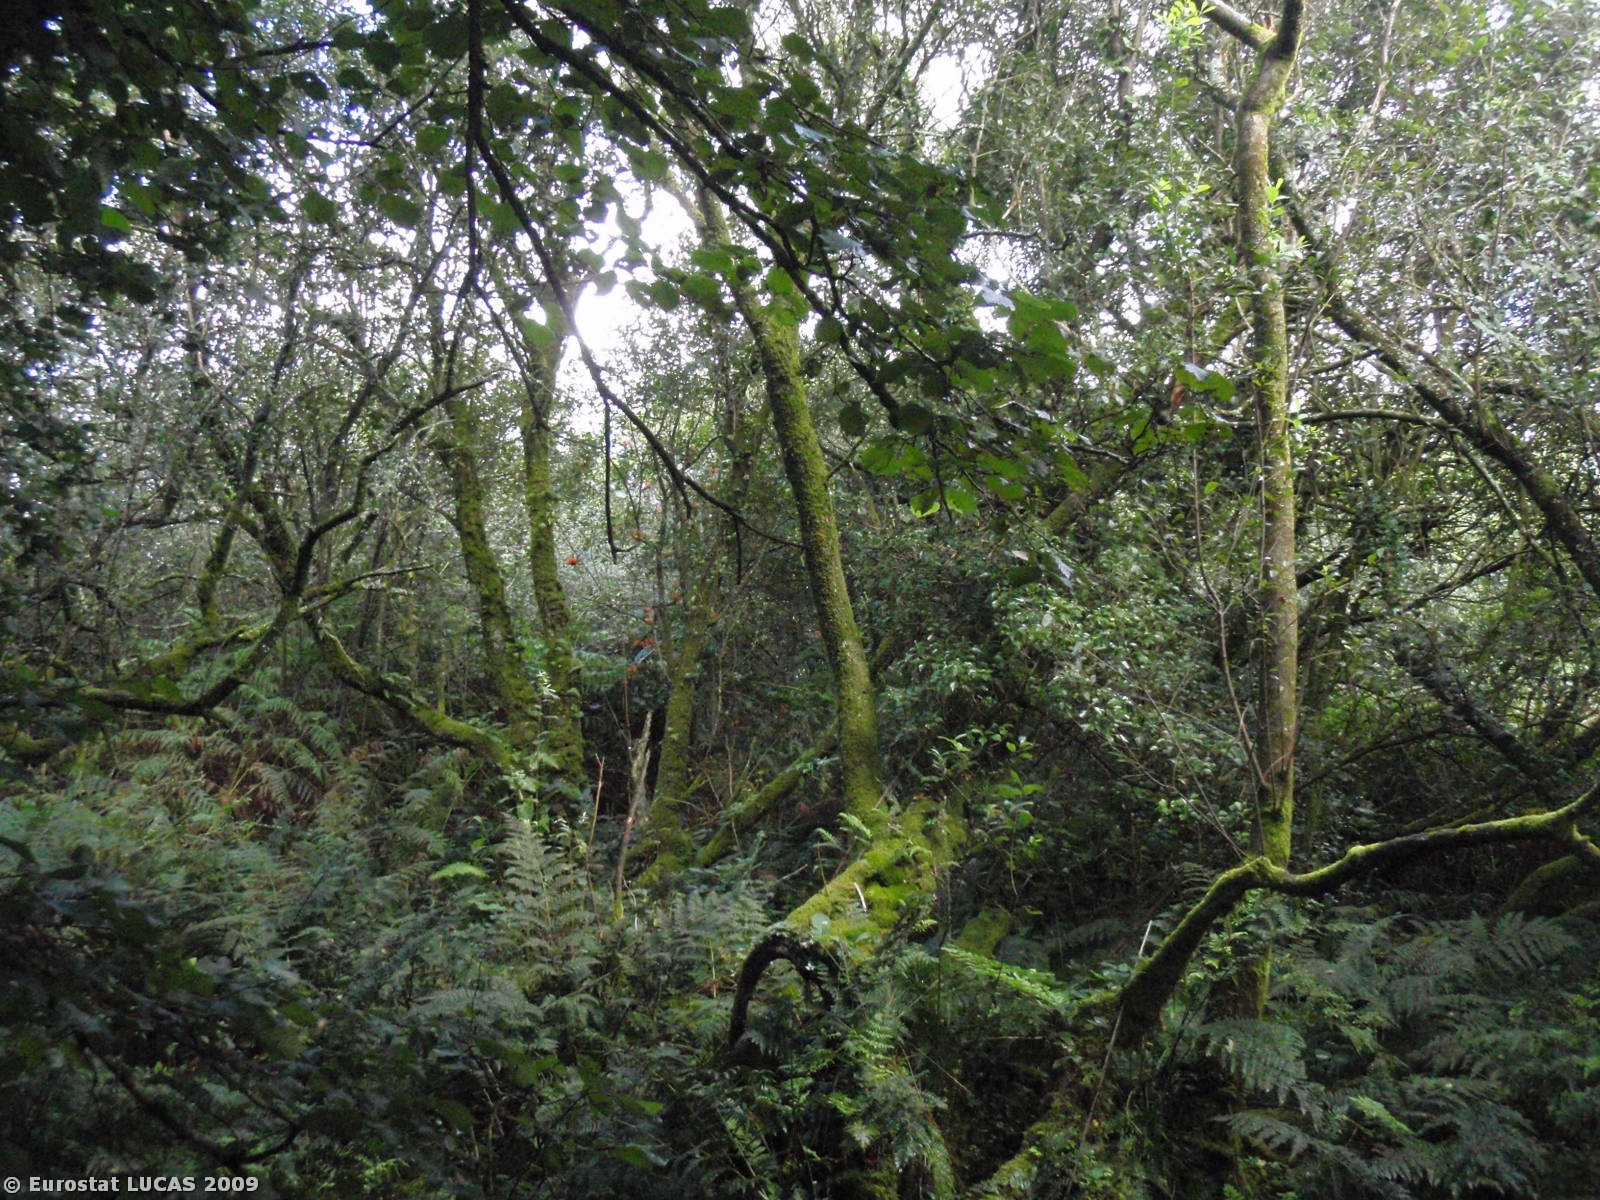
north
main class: Woodland
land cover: Broadleaved woodland
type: floodplain forest
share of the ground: > 75 %
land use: Unused
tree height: > 5 m
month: August
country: GB
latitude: 50.9265
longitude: -4.4011
